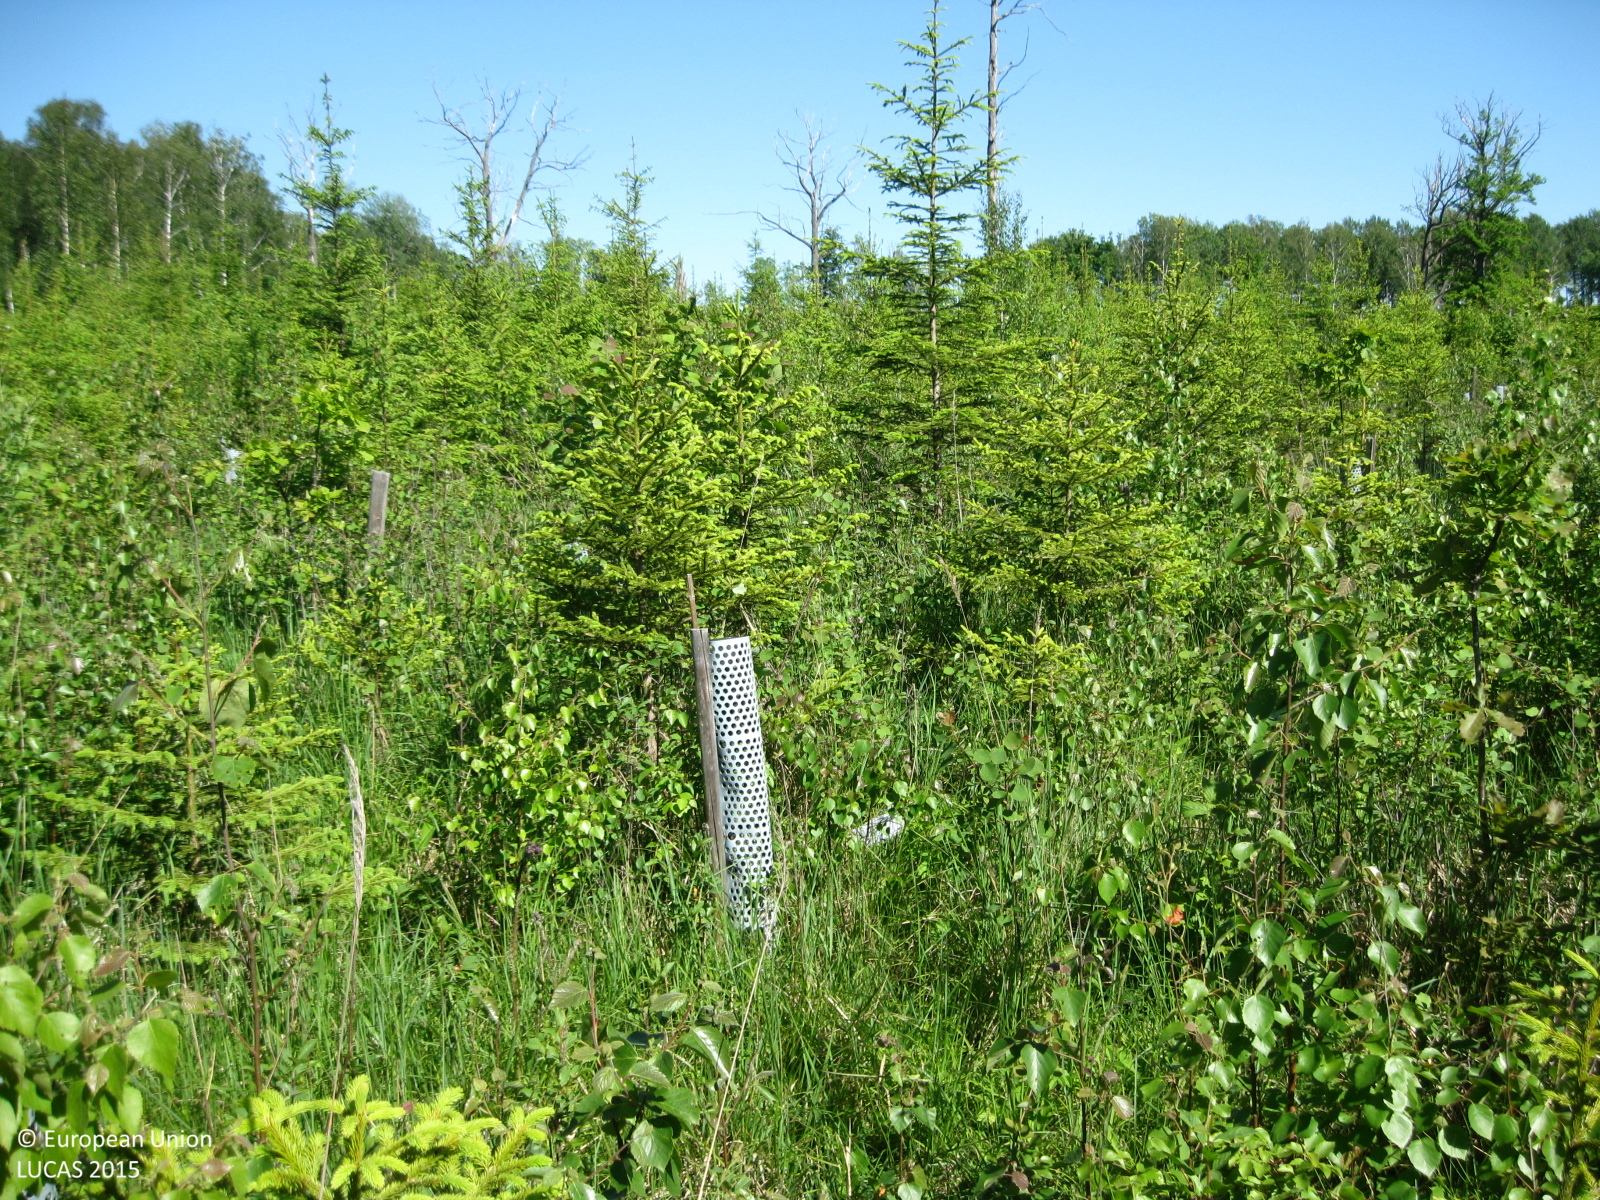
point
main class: Woodland
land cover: Spruce dominated mixed woodland
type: hemiboreal forest and nemoral coniferous forest and mixed broadleaved-coniferous forest
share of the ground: 50 - 75 %
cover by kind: coniferous forest trees 35 %, broadleaved forest trees 35 %, herbaceous plants 20 %, shrubs 10 %
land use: Forestry
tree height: < 5 m
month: June
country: LT
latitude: 55.6638
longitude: 24.0632
